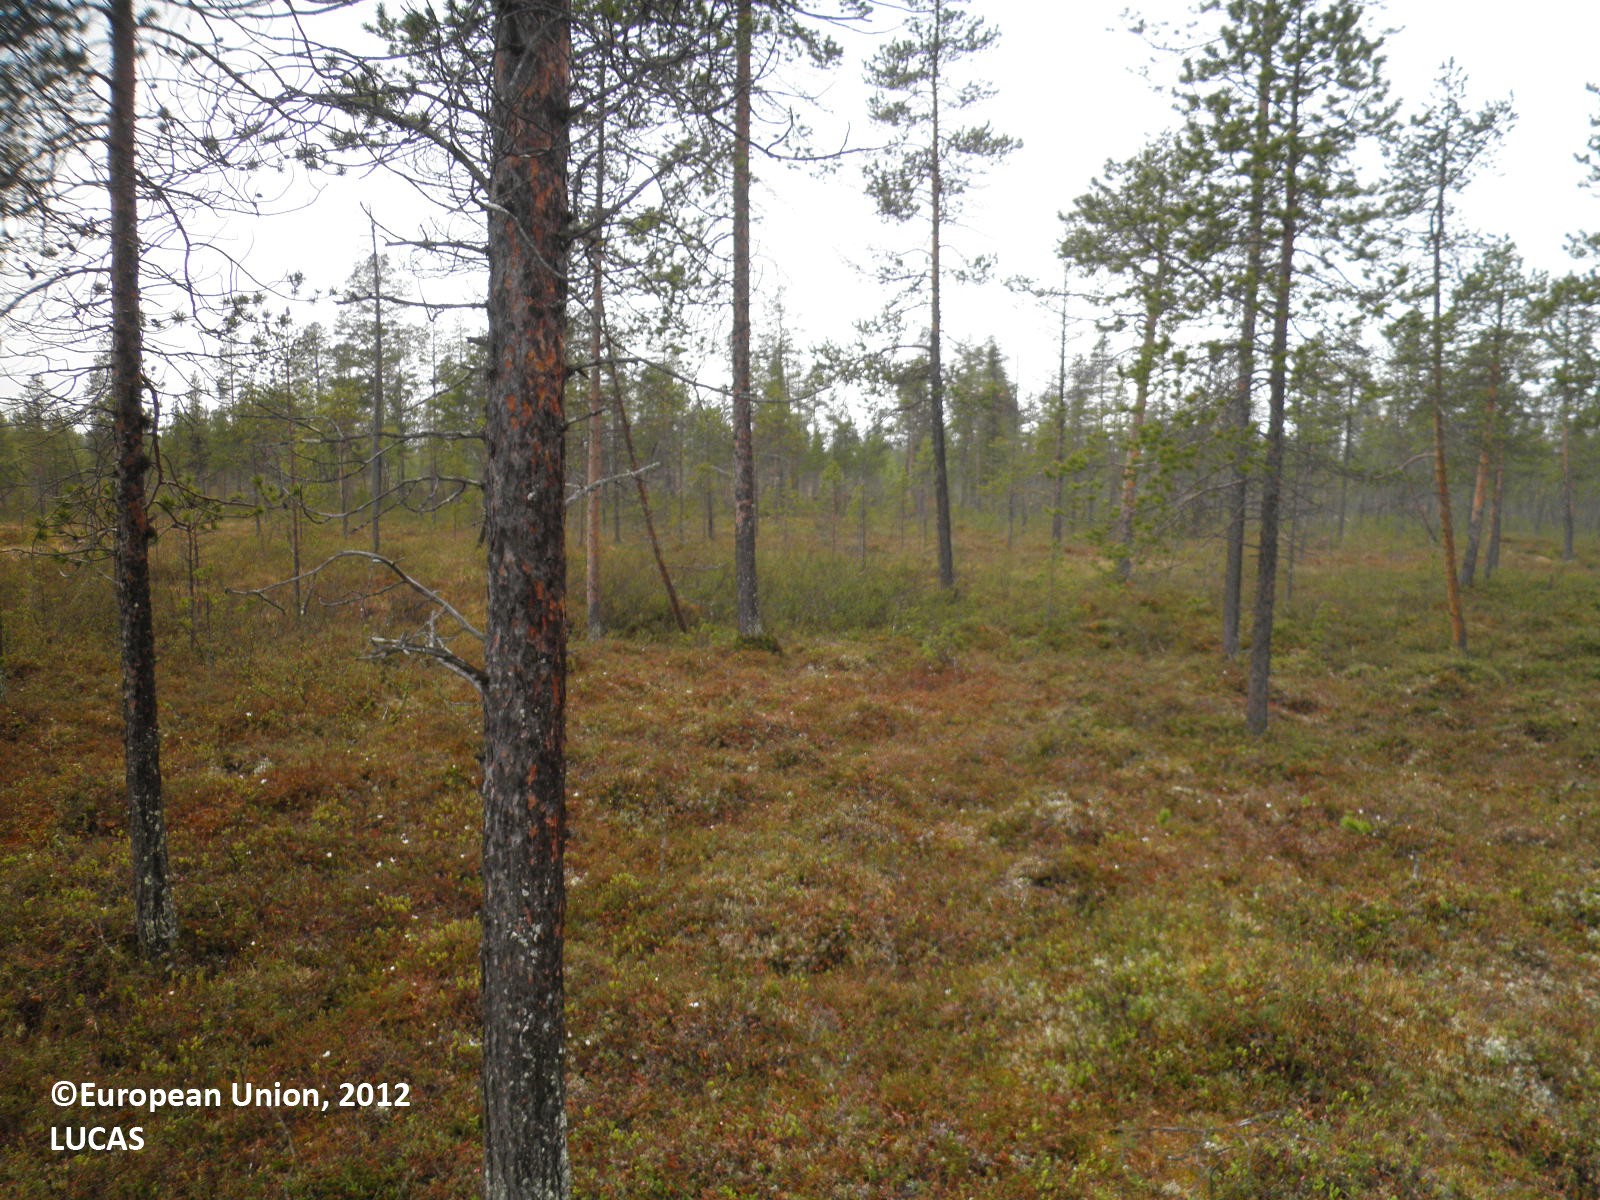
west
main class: Woodland
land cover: Pine dominated coniferous woodland
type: boreal forest
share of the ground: 25 - 50 %
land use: Forestry
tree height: > 5 m
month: June
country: FI
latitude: 68.9019
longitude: 26.5016
